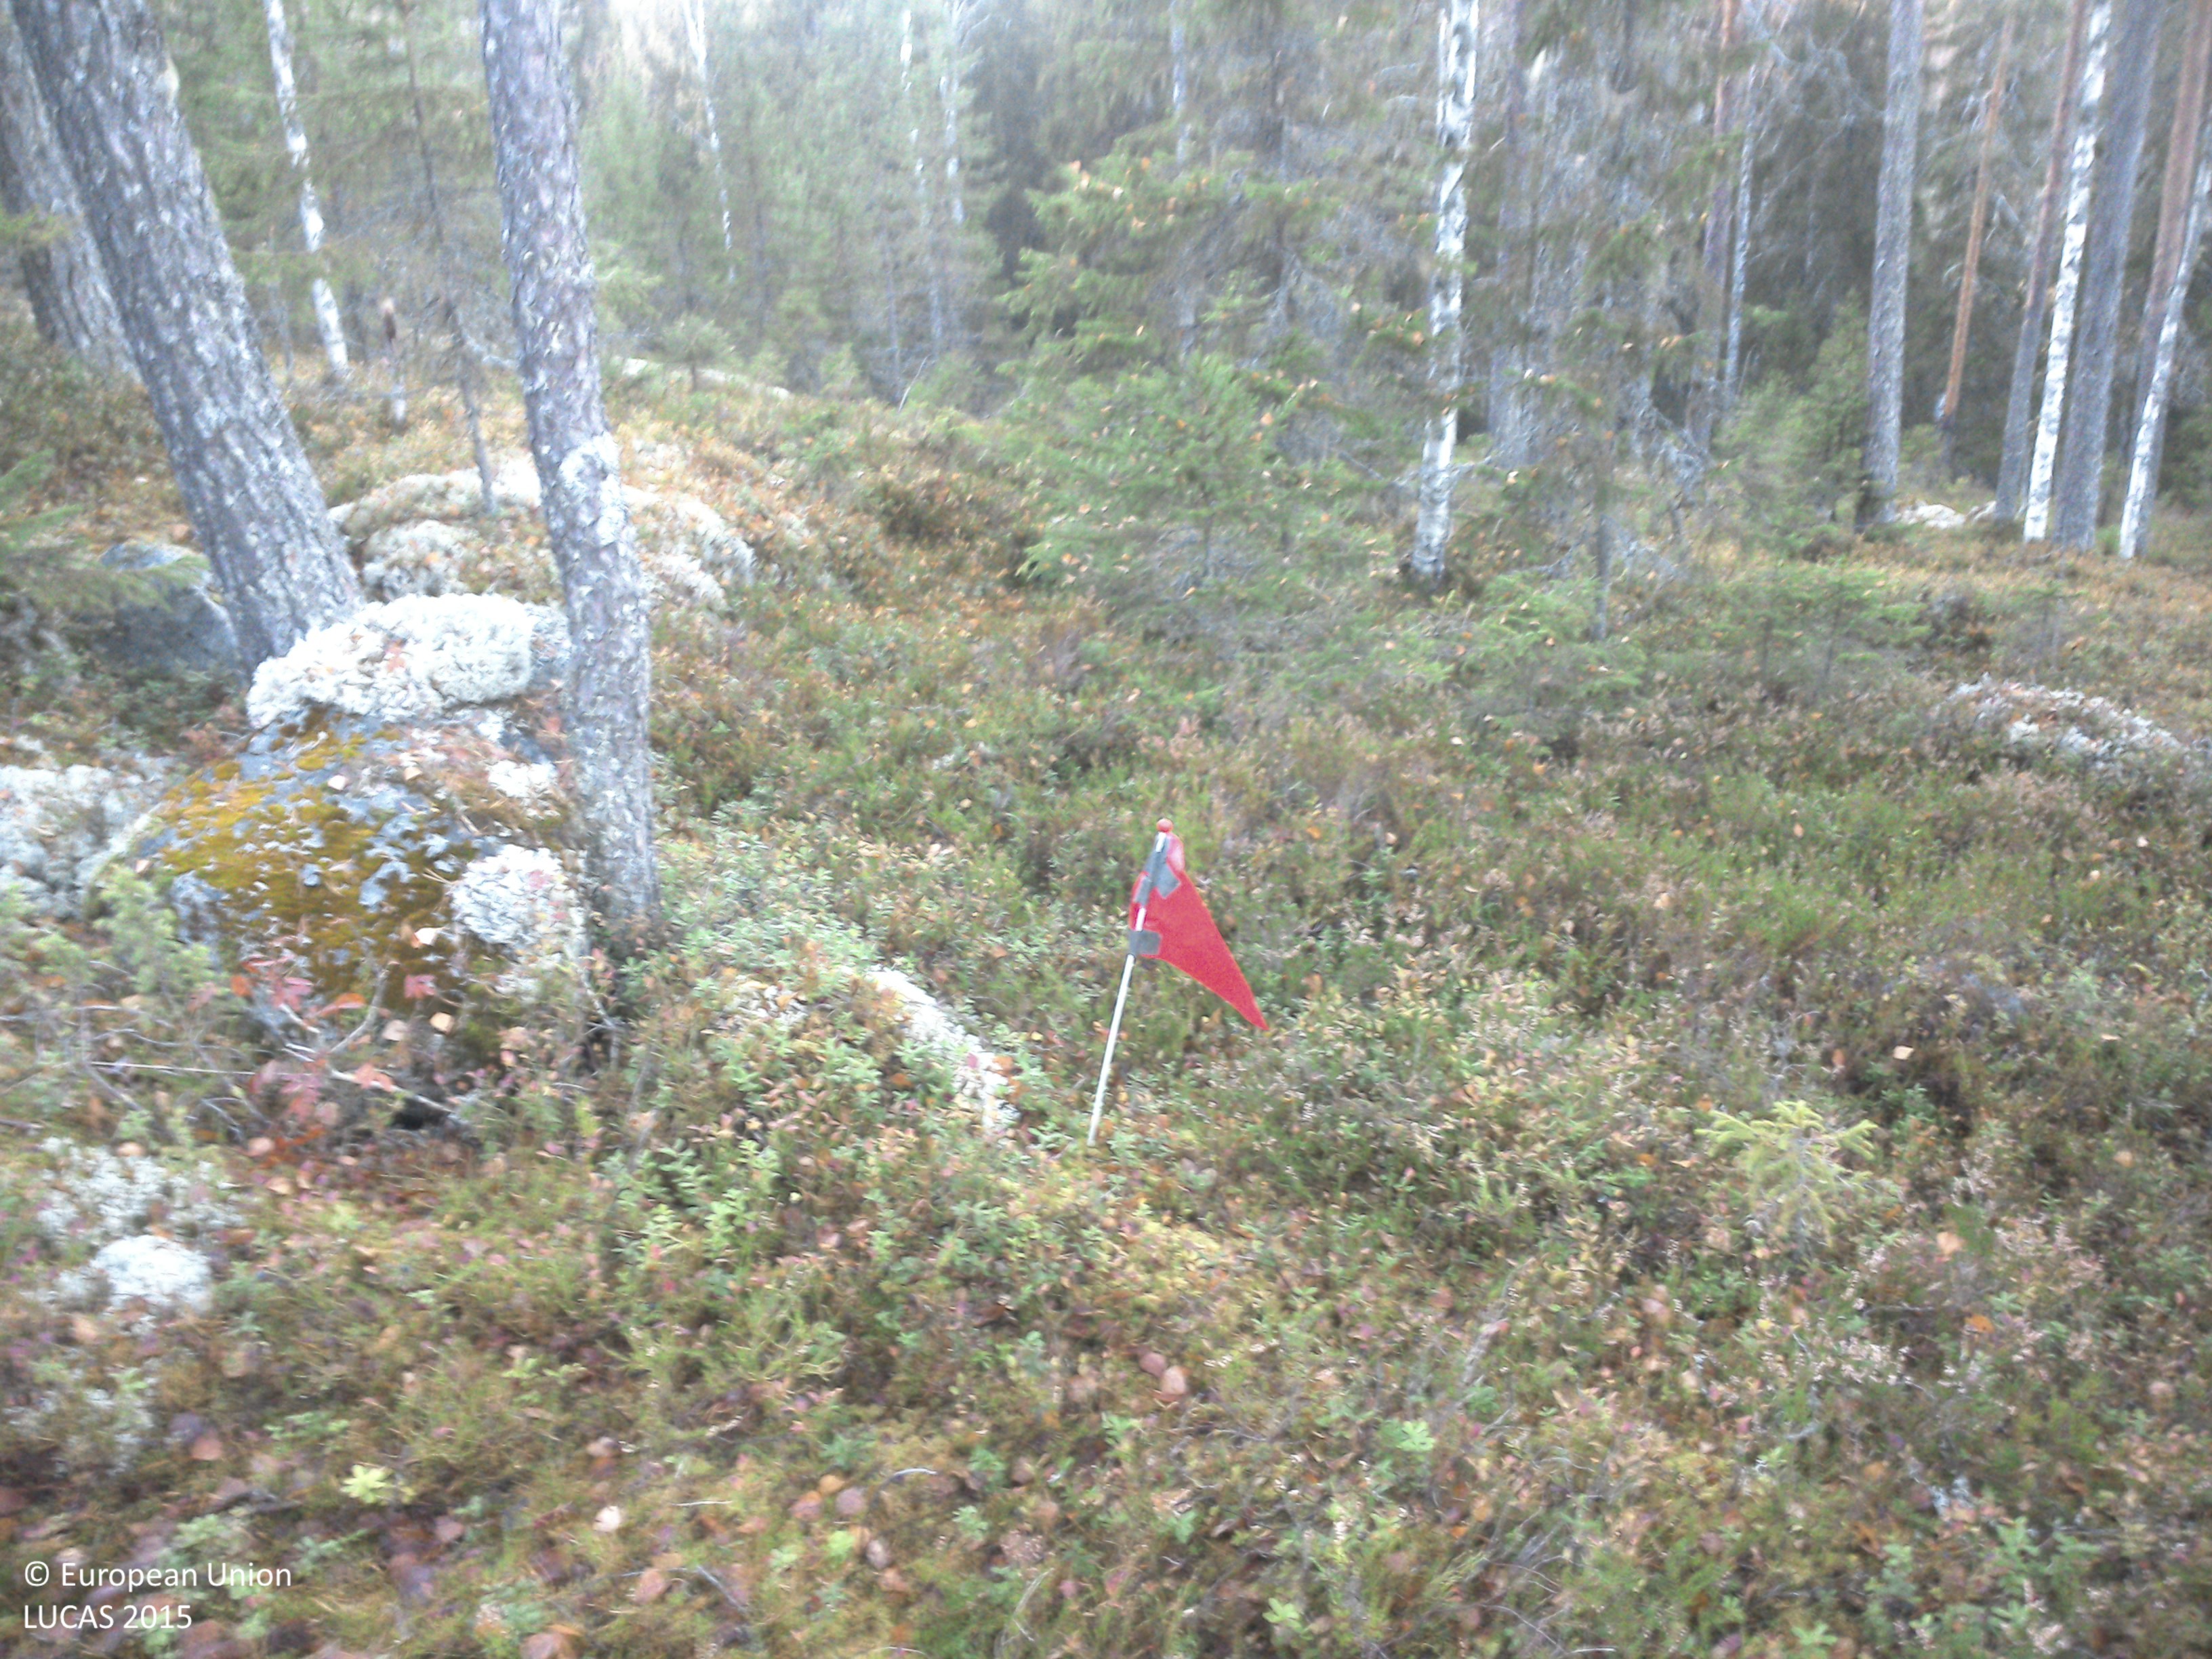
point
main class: Woodland
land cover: Pine dominated mixed woodland
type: boreal forest
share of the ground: 25 - 50 %
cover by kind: shrubs 50 %, coniferous forest trees 30 %, broadleaved forest trees 20 %
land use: Forestry
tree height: > 5 m
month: October
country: SE
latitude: 63.8727
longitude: 19.8502
